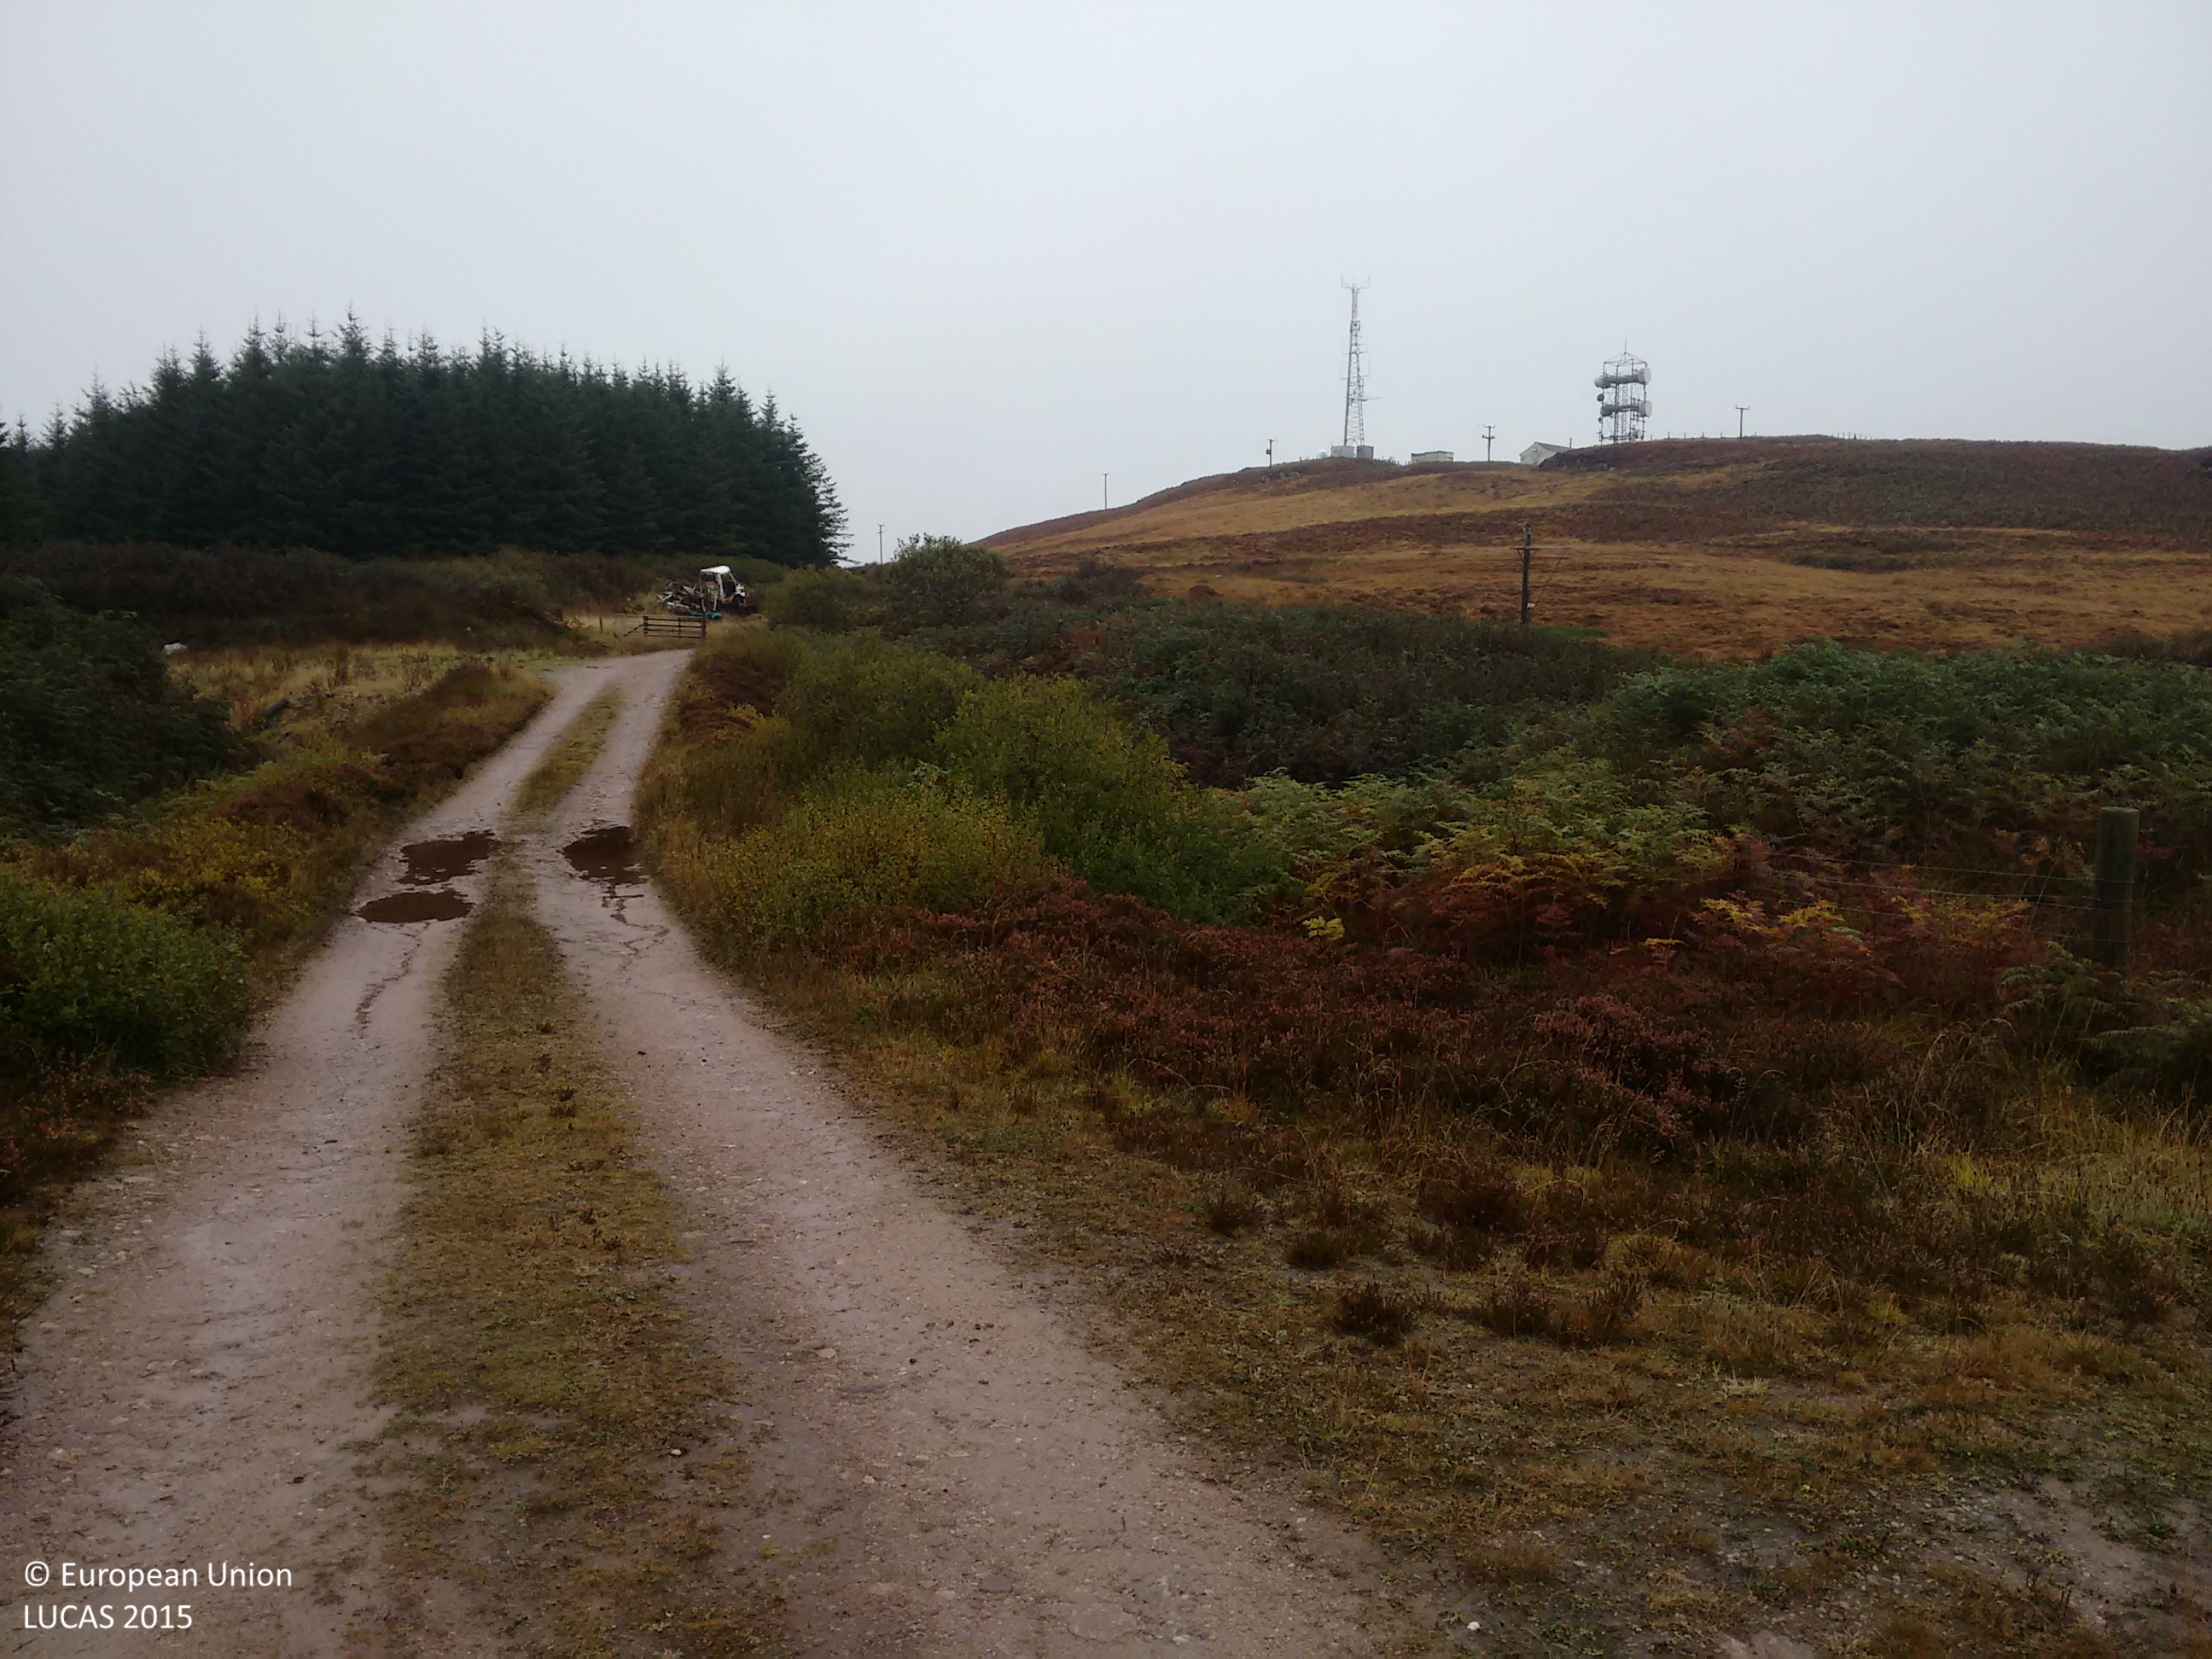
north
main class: Shrubland
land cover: Shrubland without tree cover
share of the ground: > 75 %
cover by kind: shrubs 80 %, herbaceous plants 20 %
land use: Semi-natural and natural areas not in use
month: October
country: GB
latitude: 55.6220
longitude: -6.2302
